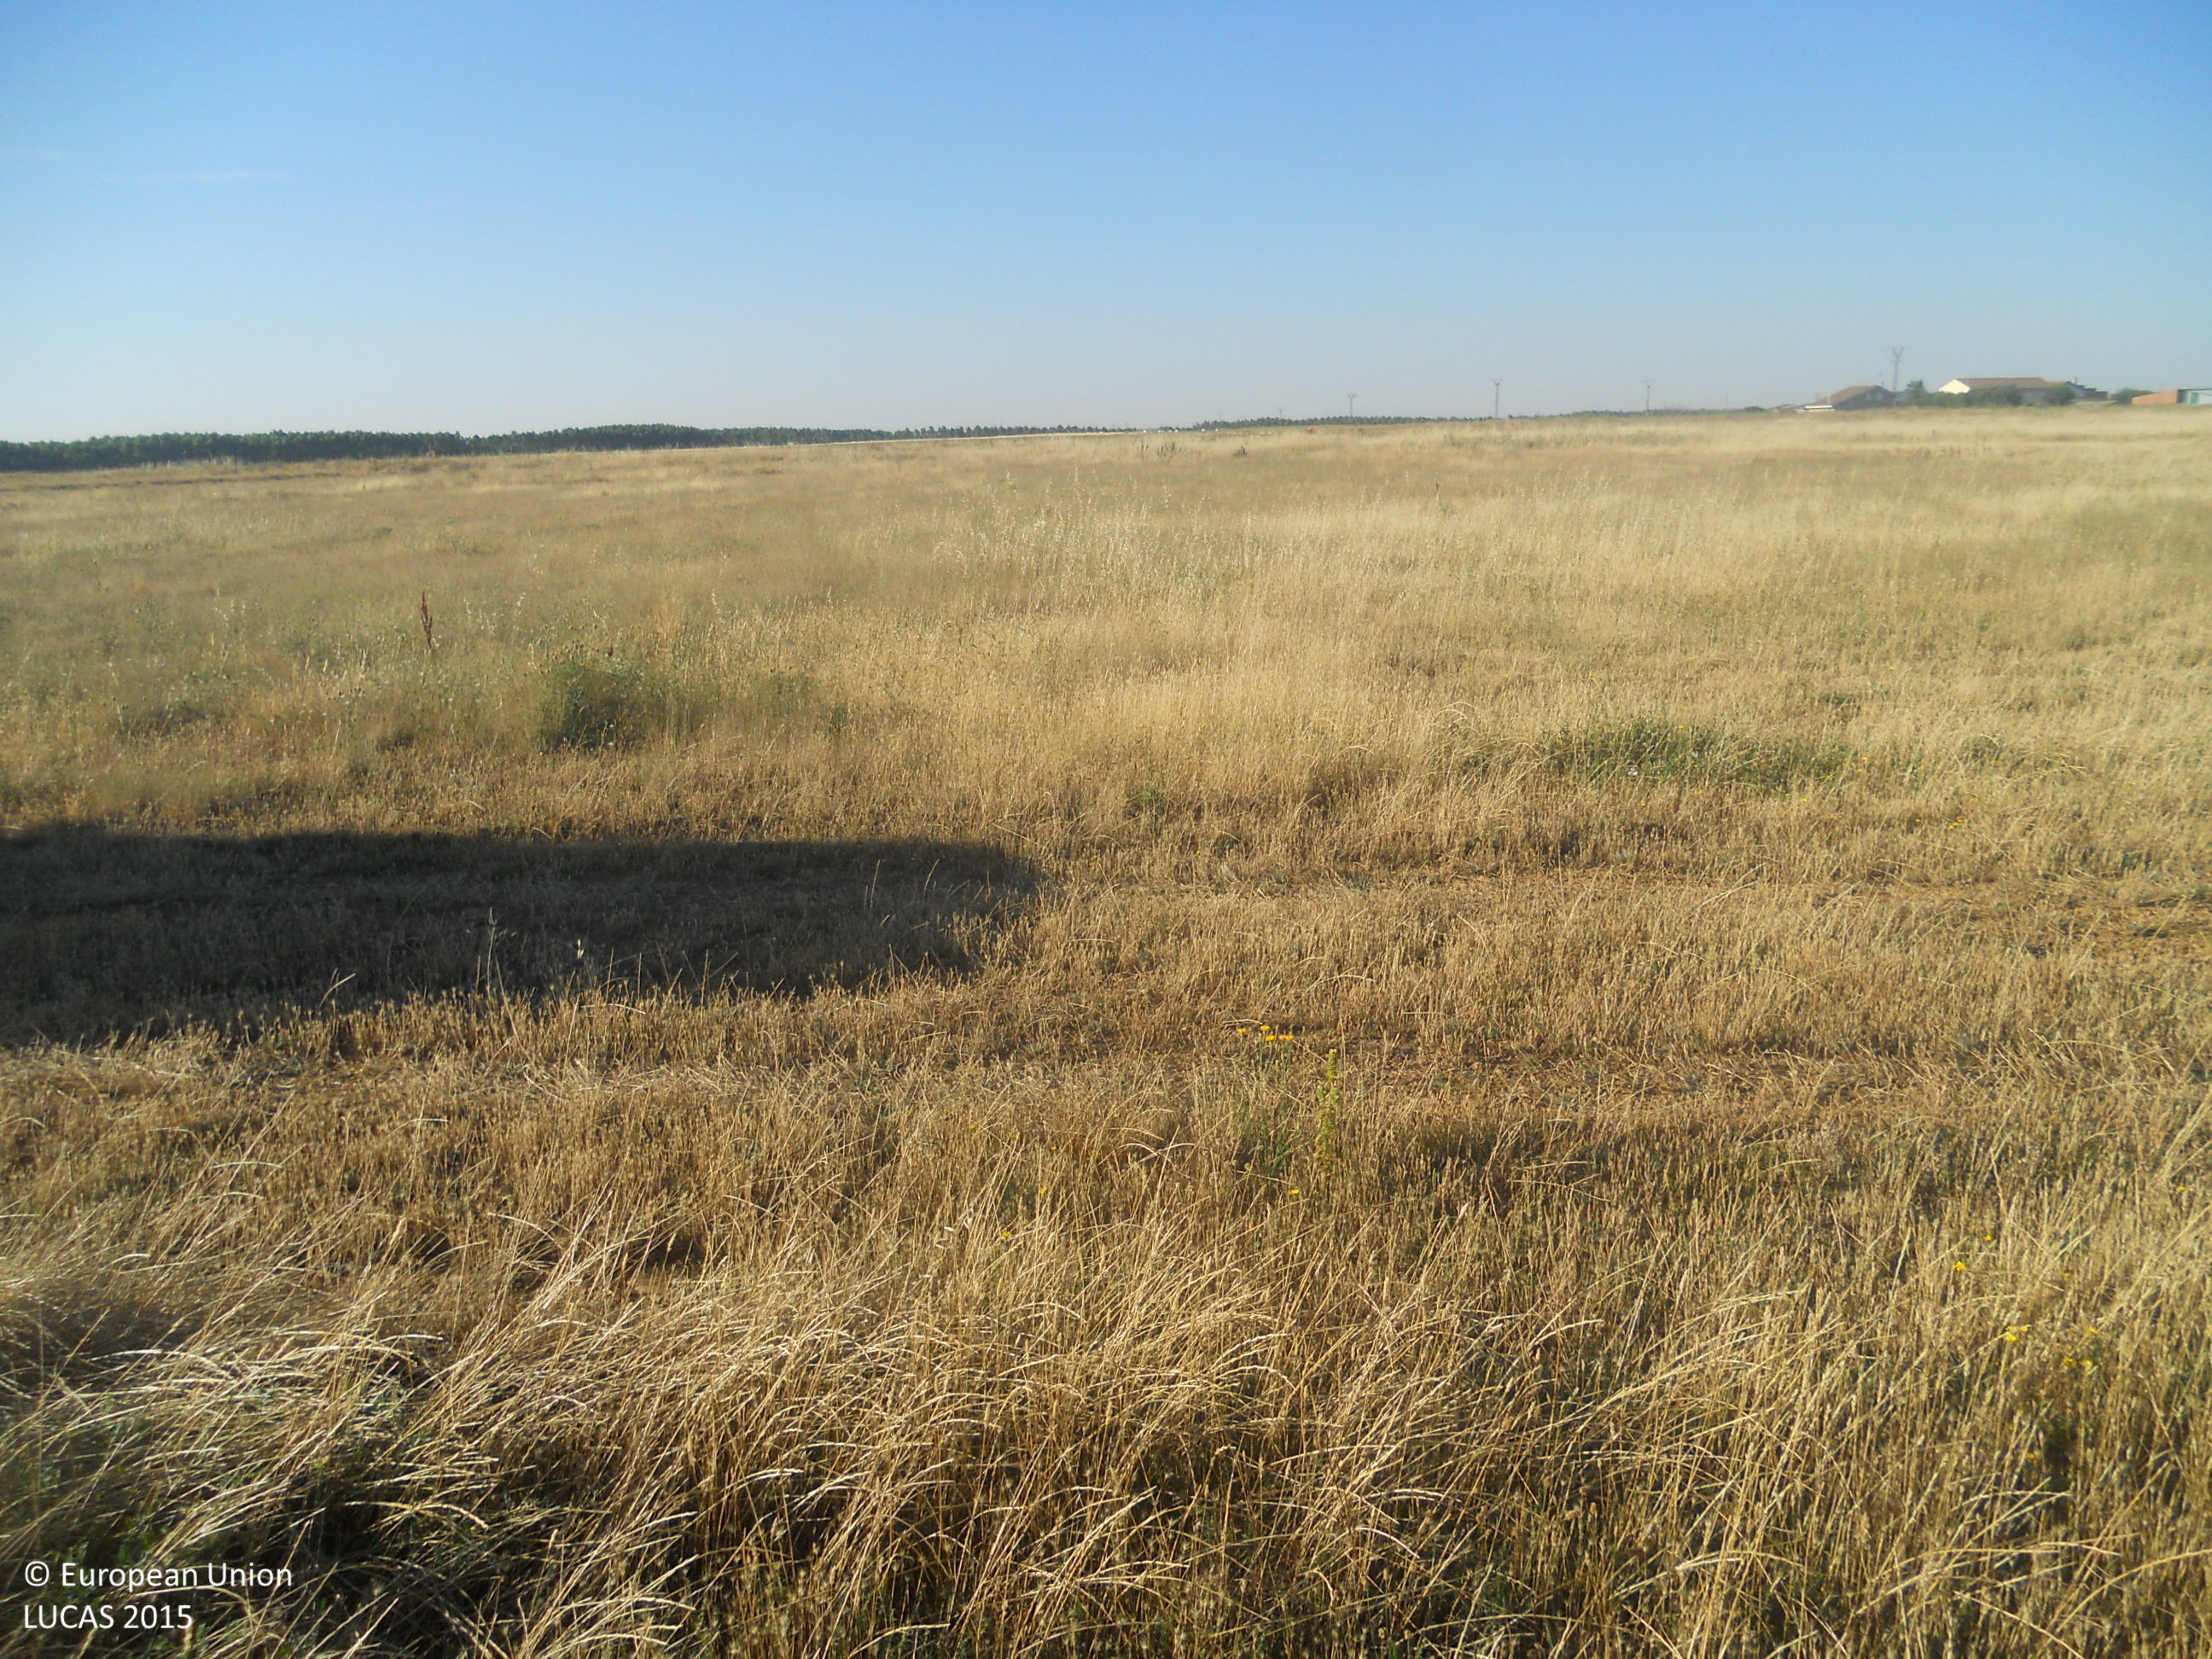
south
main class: Grassland
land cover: Grassland without tree/shrub cover
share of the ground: > 75 %
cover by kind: herbaceous plants 100 %
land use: Abandoned areas
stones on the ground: > 50 %
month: July
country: ES
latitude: 42.4557
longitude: -5.3020
